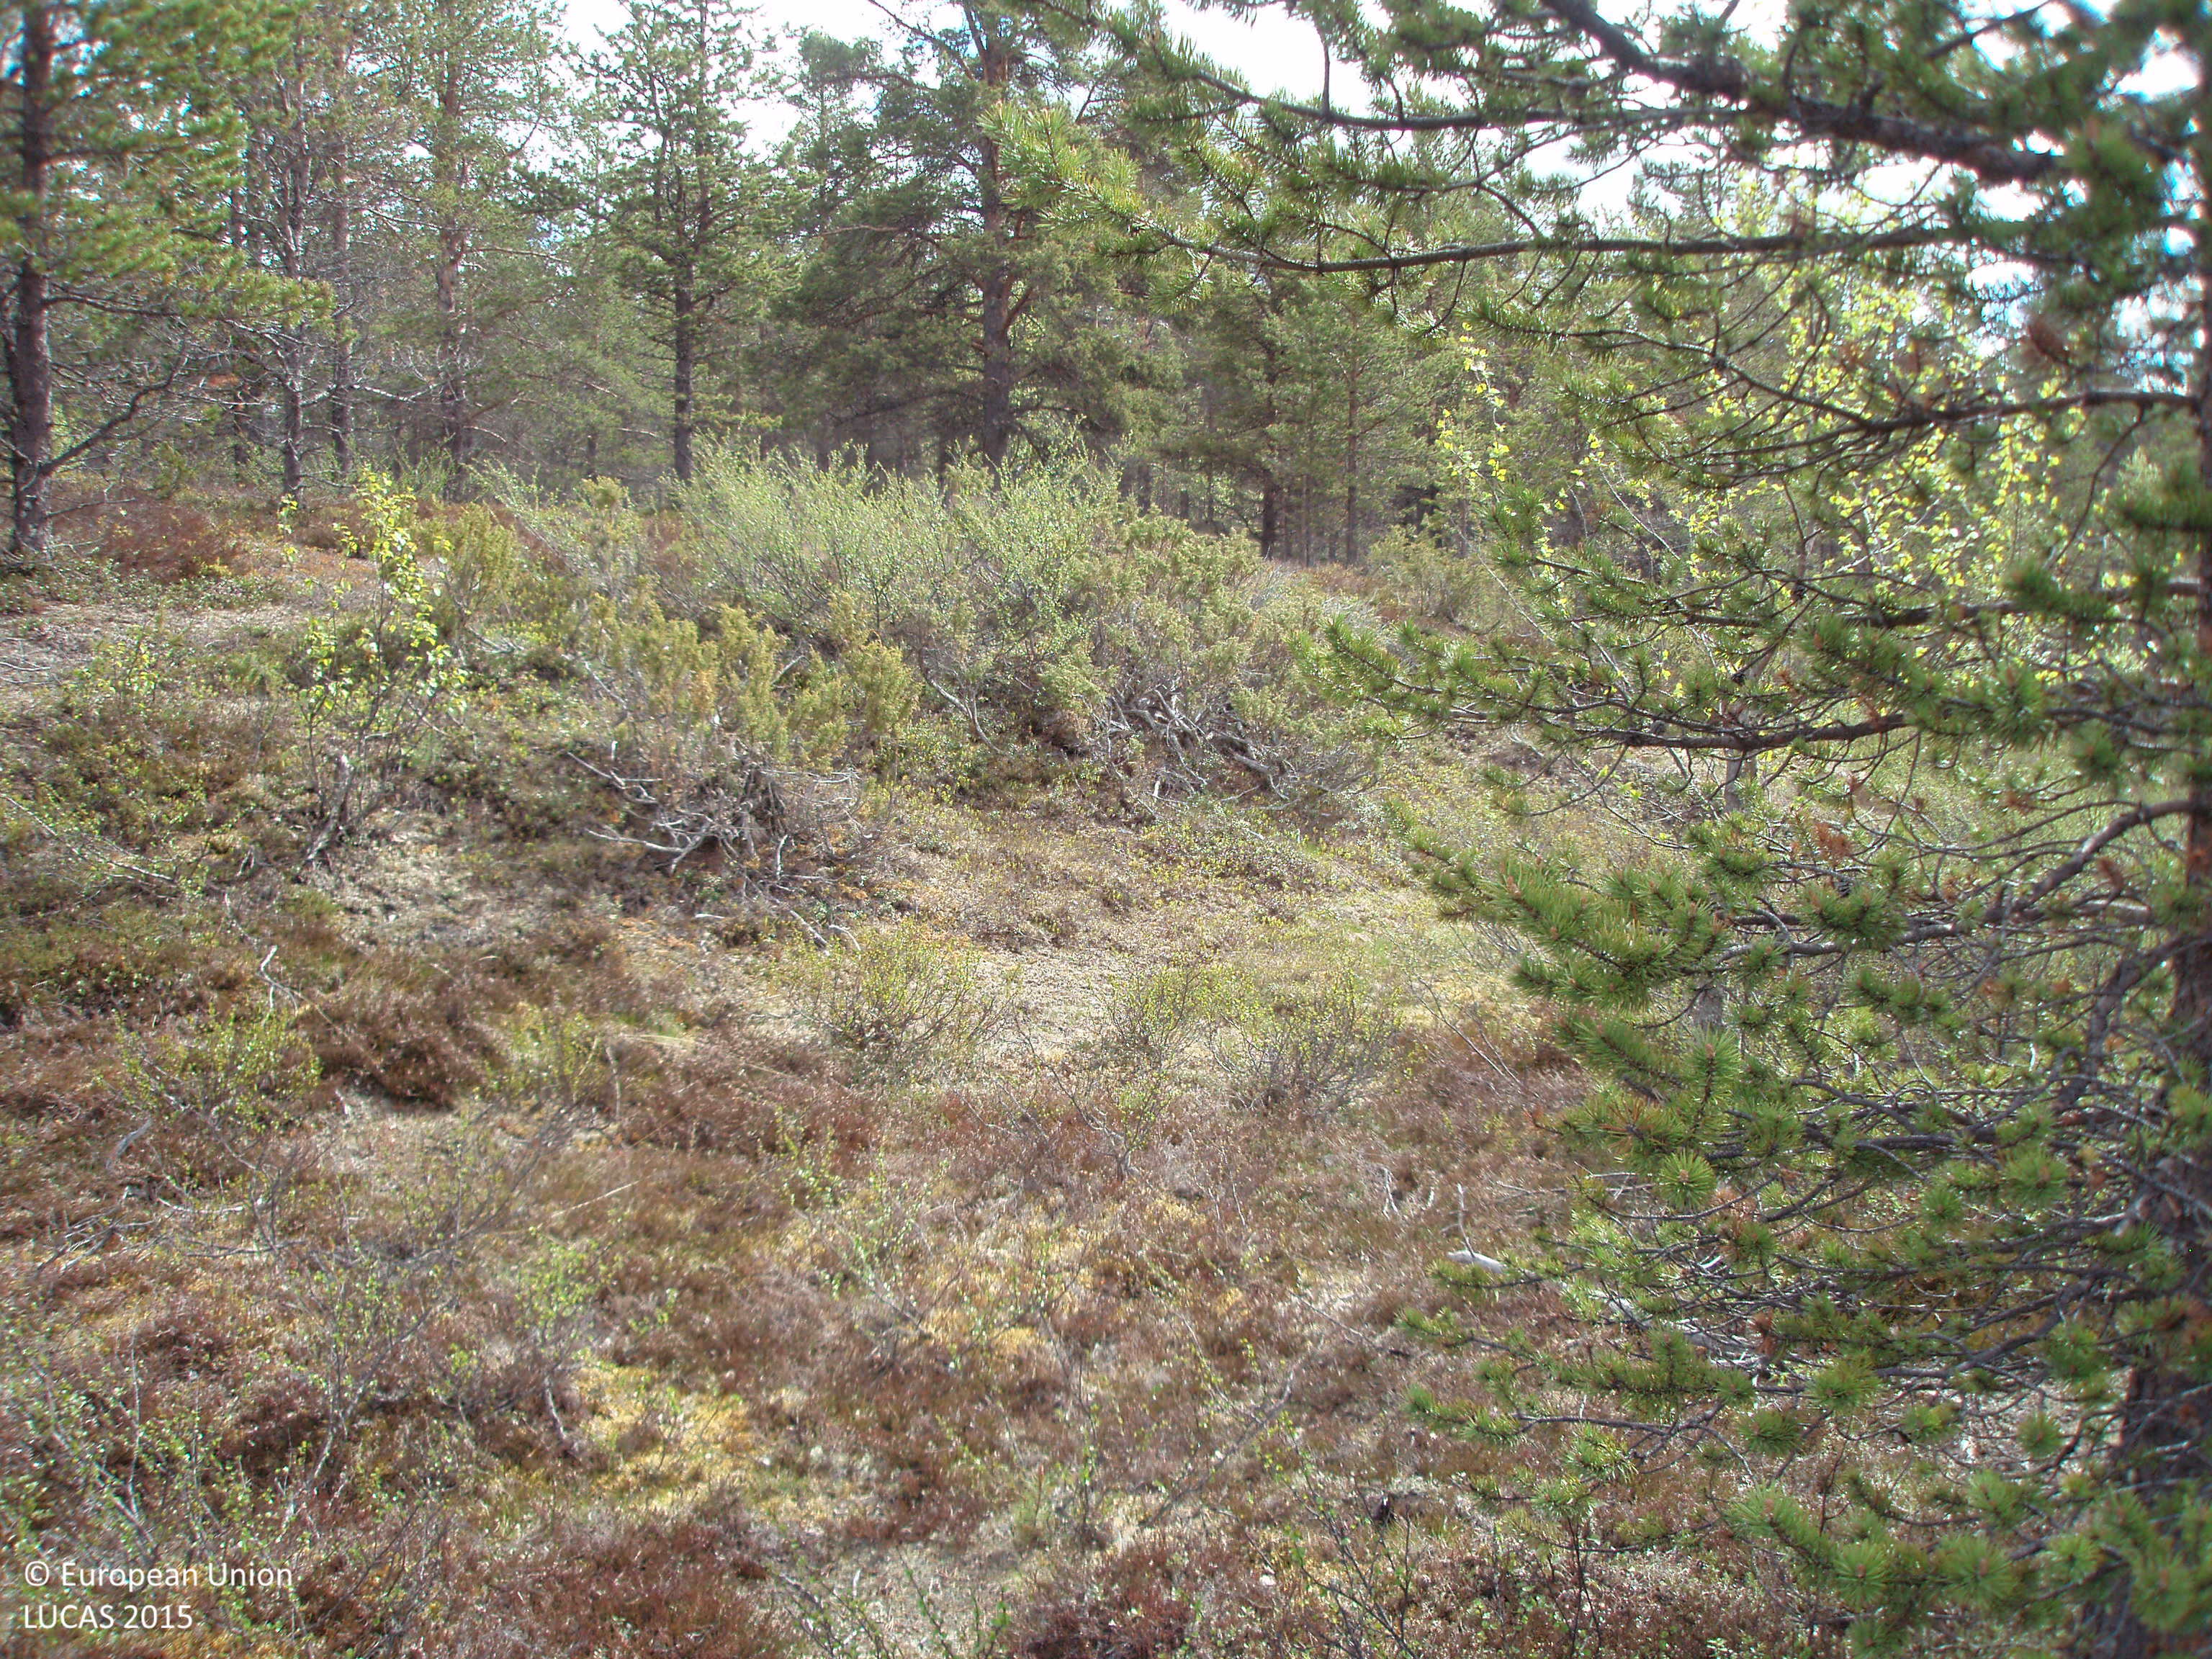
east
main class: Shrubland
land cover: Shrubland with sparse tree cover
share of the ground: > 75 %
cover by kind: shrubs 75 %, lichens and mosses 20 %, coniferous forest trees 5 %
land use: Semi-natural and natural areas not in use
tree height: > 5 m
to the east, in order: Shrubland with sparse tree cover; Pine dominated mixed woodland; Pine dominated coniferous woodland
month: June
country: FI
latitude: 68.3950
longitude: 26.9318
